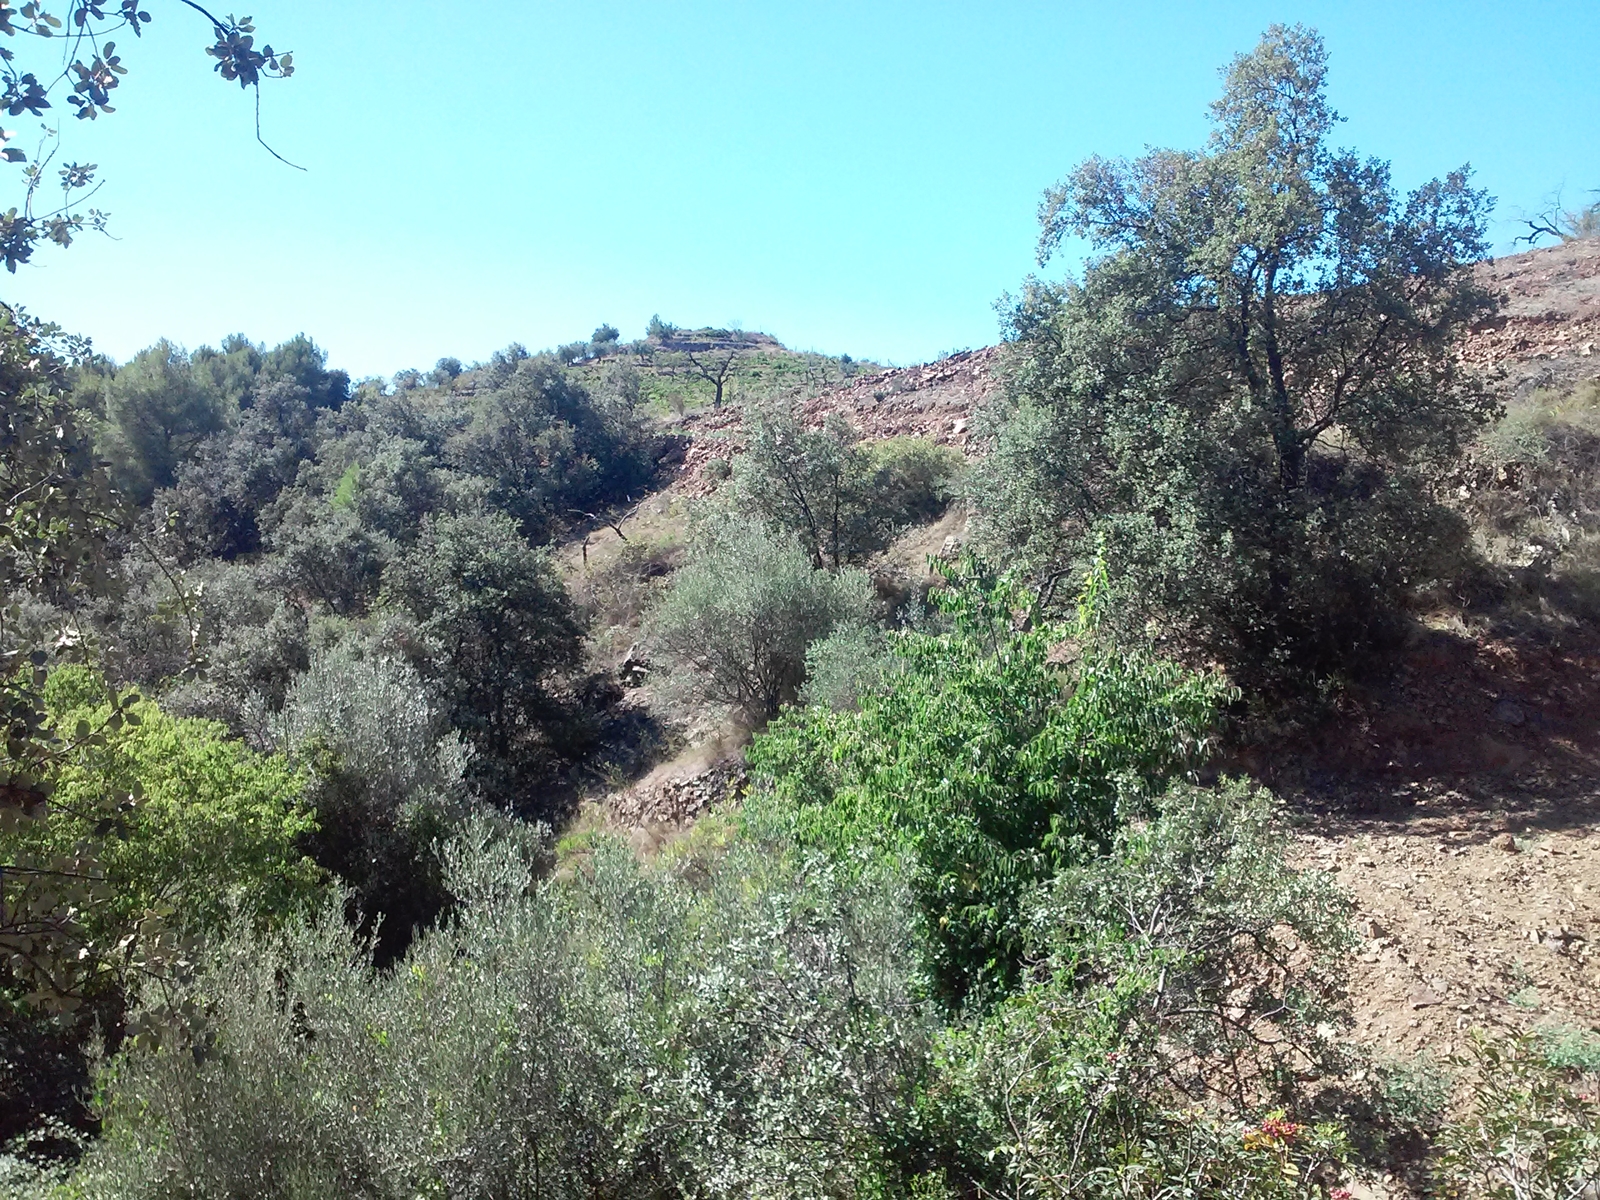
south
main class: Woodland
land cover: Pine dominated mixed woodland
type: coniferous forest of the mediterranean region
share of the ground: 50 - 75 %
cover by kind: shrubs 50 %, coniferous forest trees 25 %, broadleaved forest trees 25 %
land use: Semi-natural and natural areas not in use
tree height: < 5 m
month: September
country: ES
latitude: 41.2164
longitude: 0.7954
